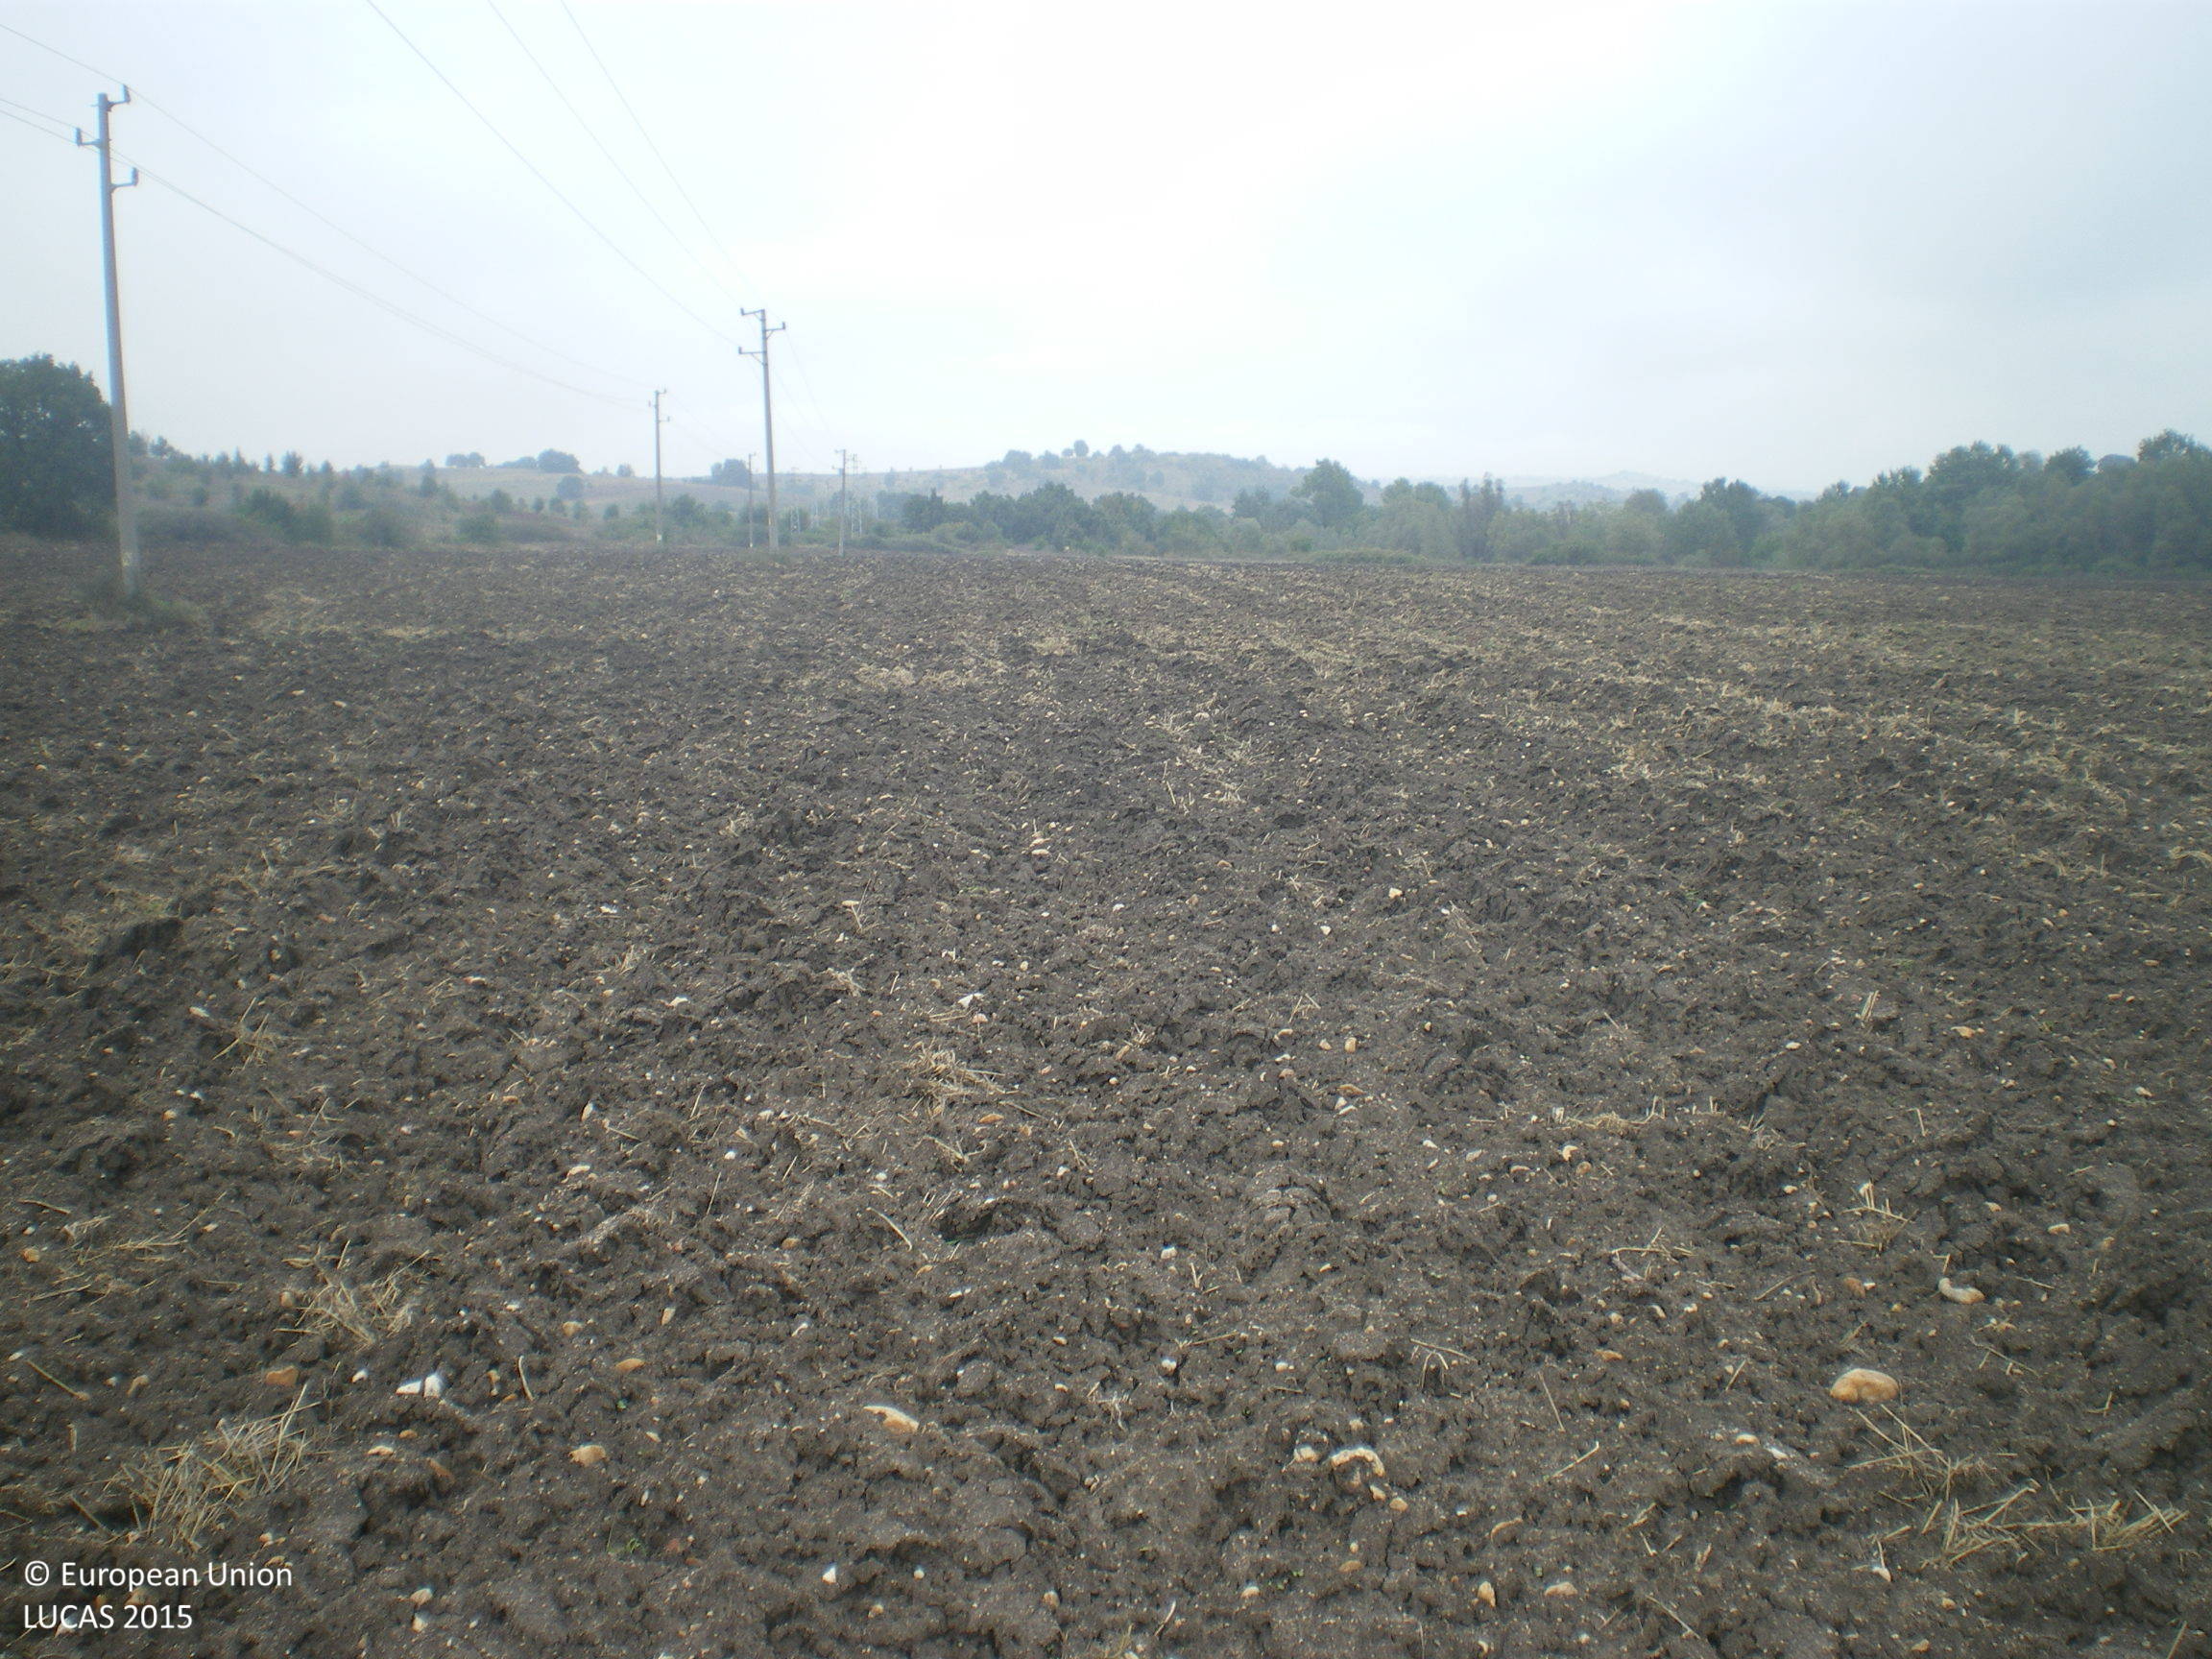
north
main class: Cropland
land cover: Common wheat
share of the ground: < 10 %
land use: Agriculture (excluding fallow land and kitchen gardens)
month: October
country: BG
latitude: 41.8184
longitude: 26.1960
